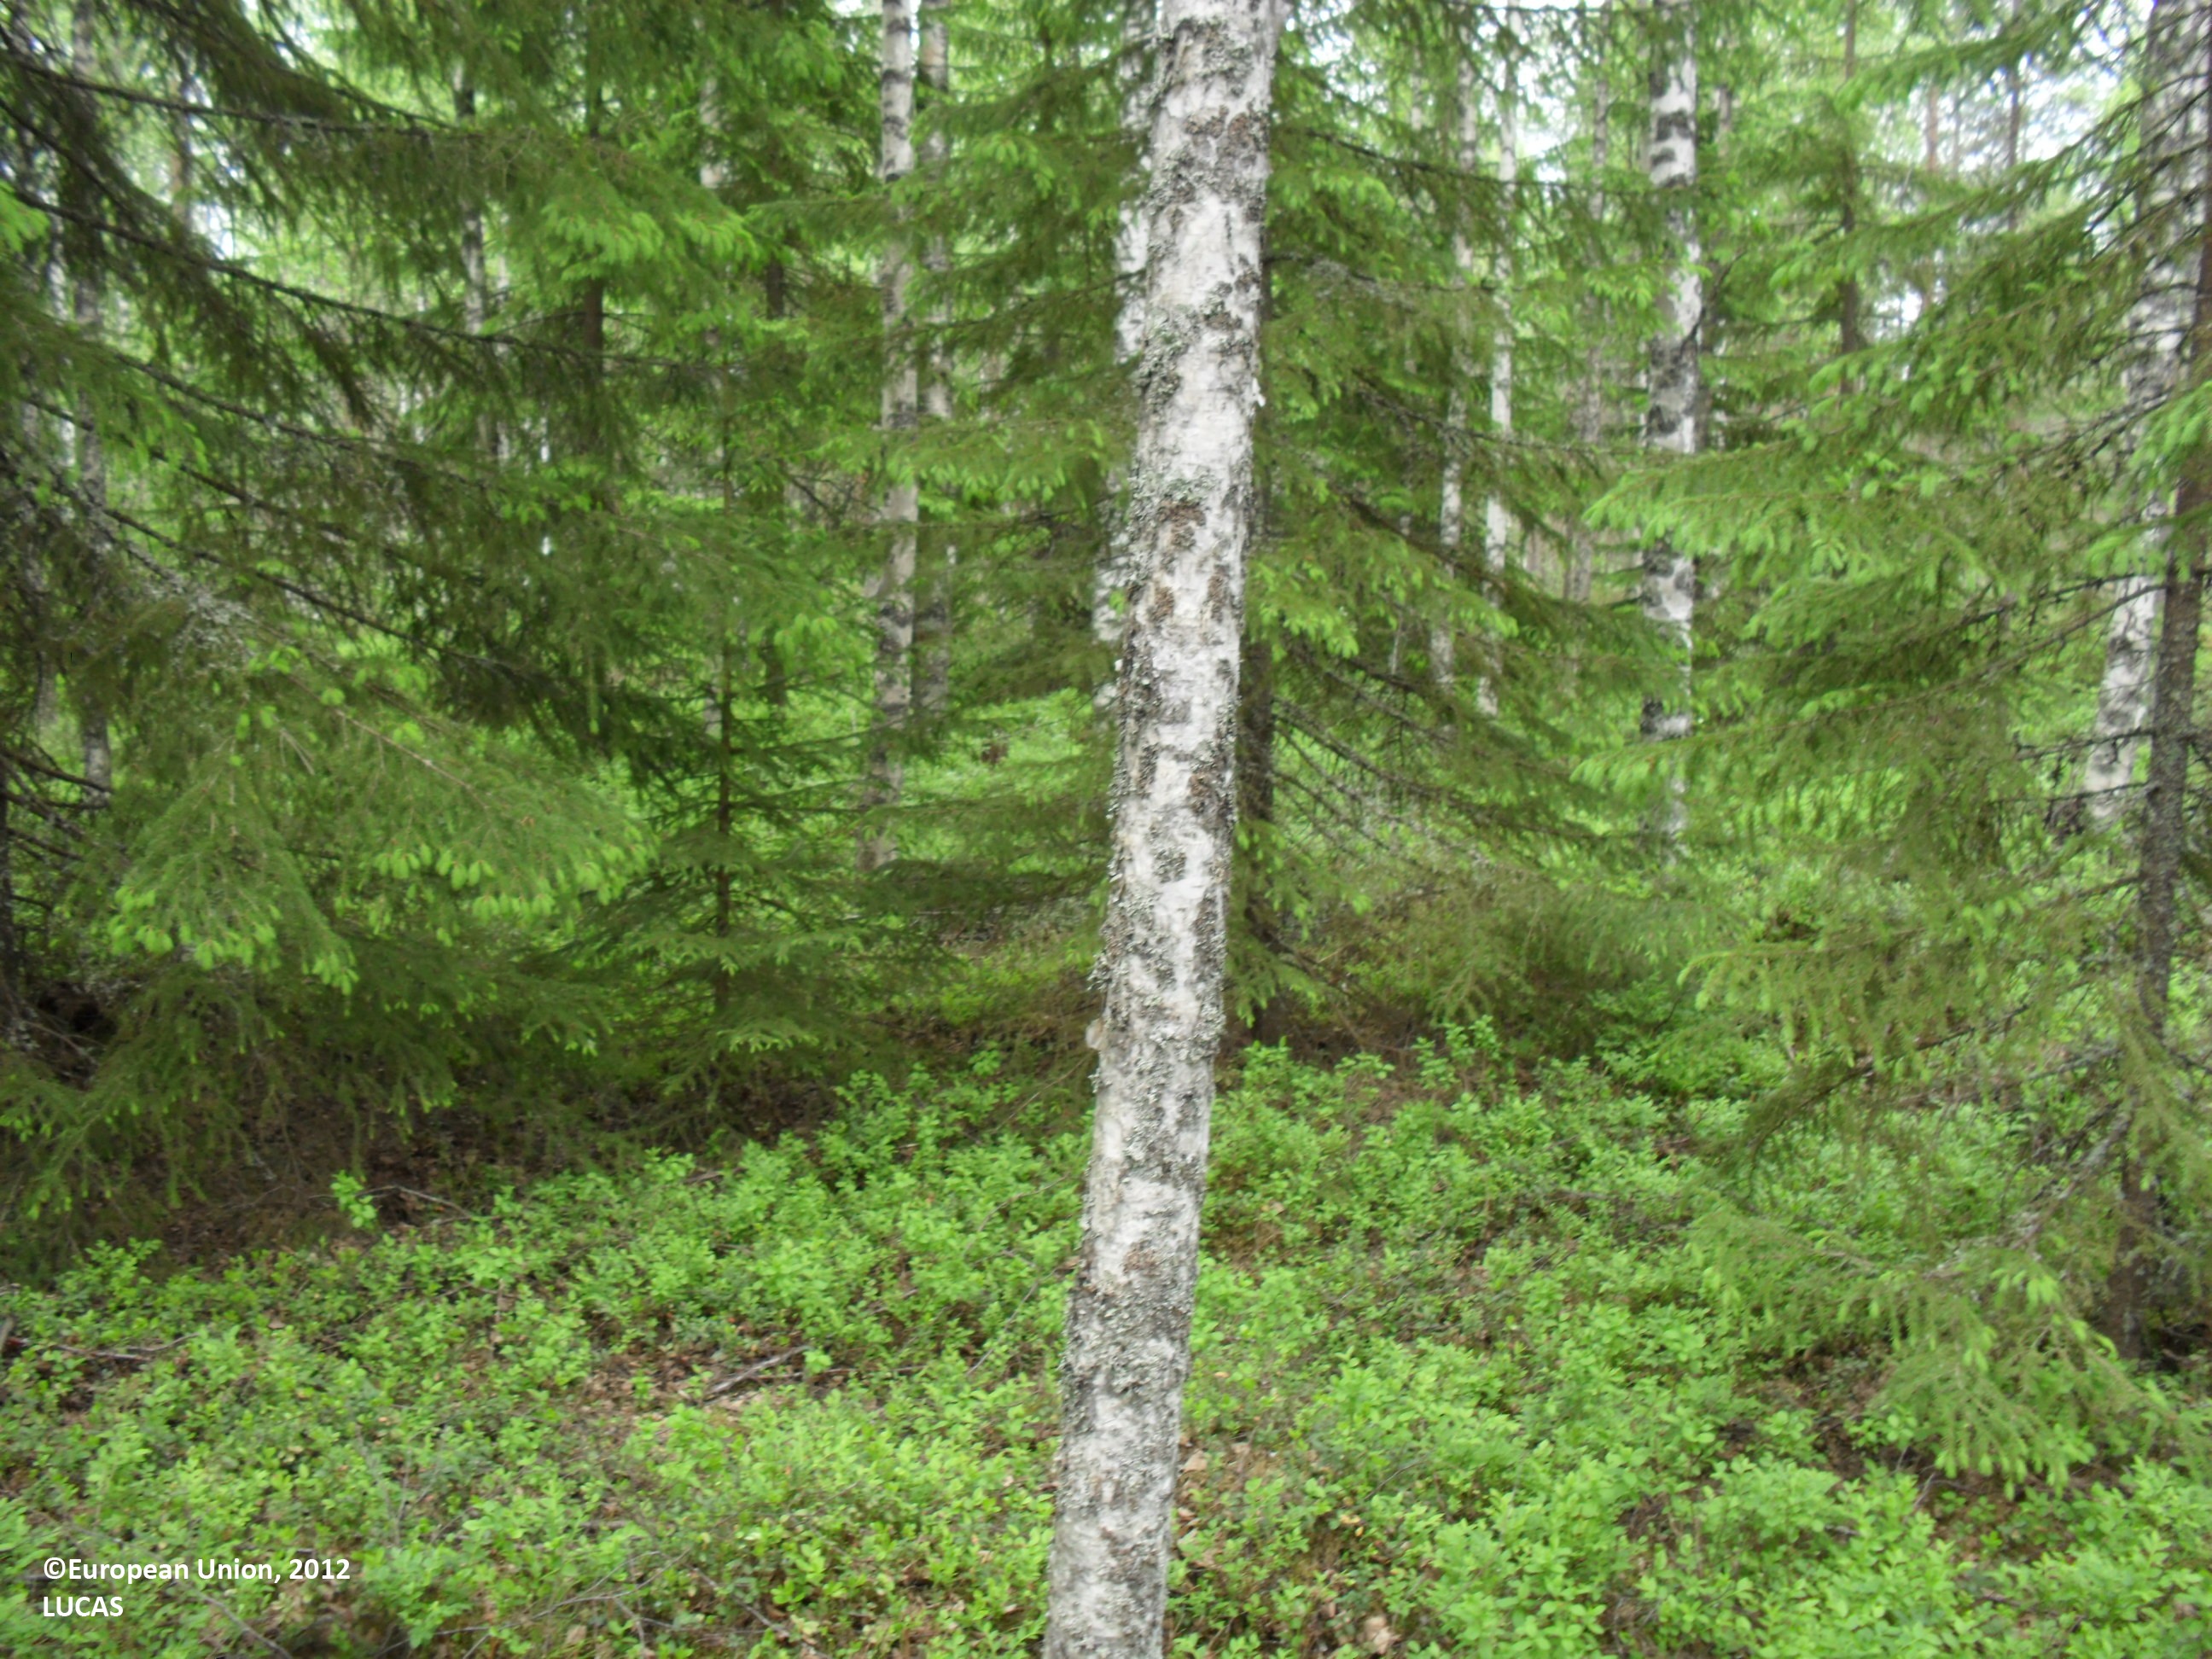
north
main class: Woodland
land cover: Other mixed woodland
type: boreal forest
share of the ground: 50 - 75 %
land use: Forestry
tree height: > 5 m
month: June
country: FI
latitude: 63.2412
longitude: 23.5833
